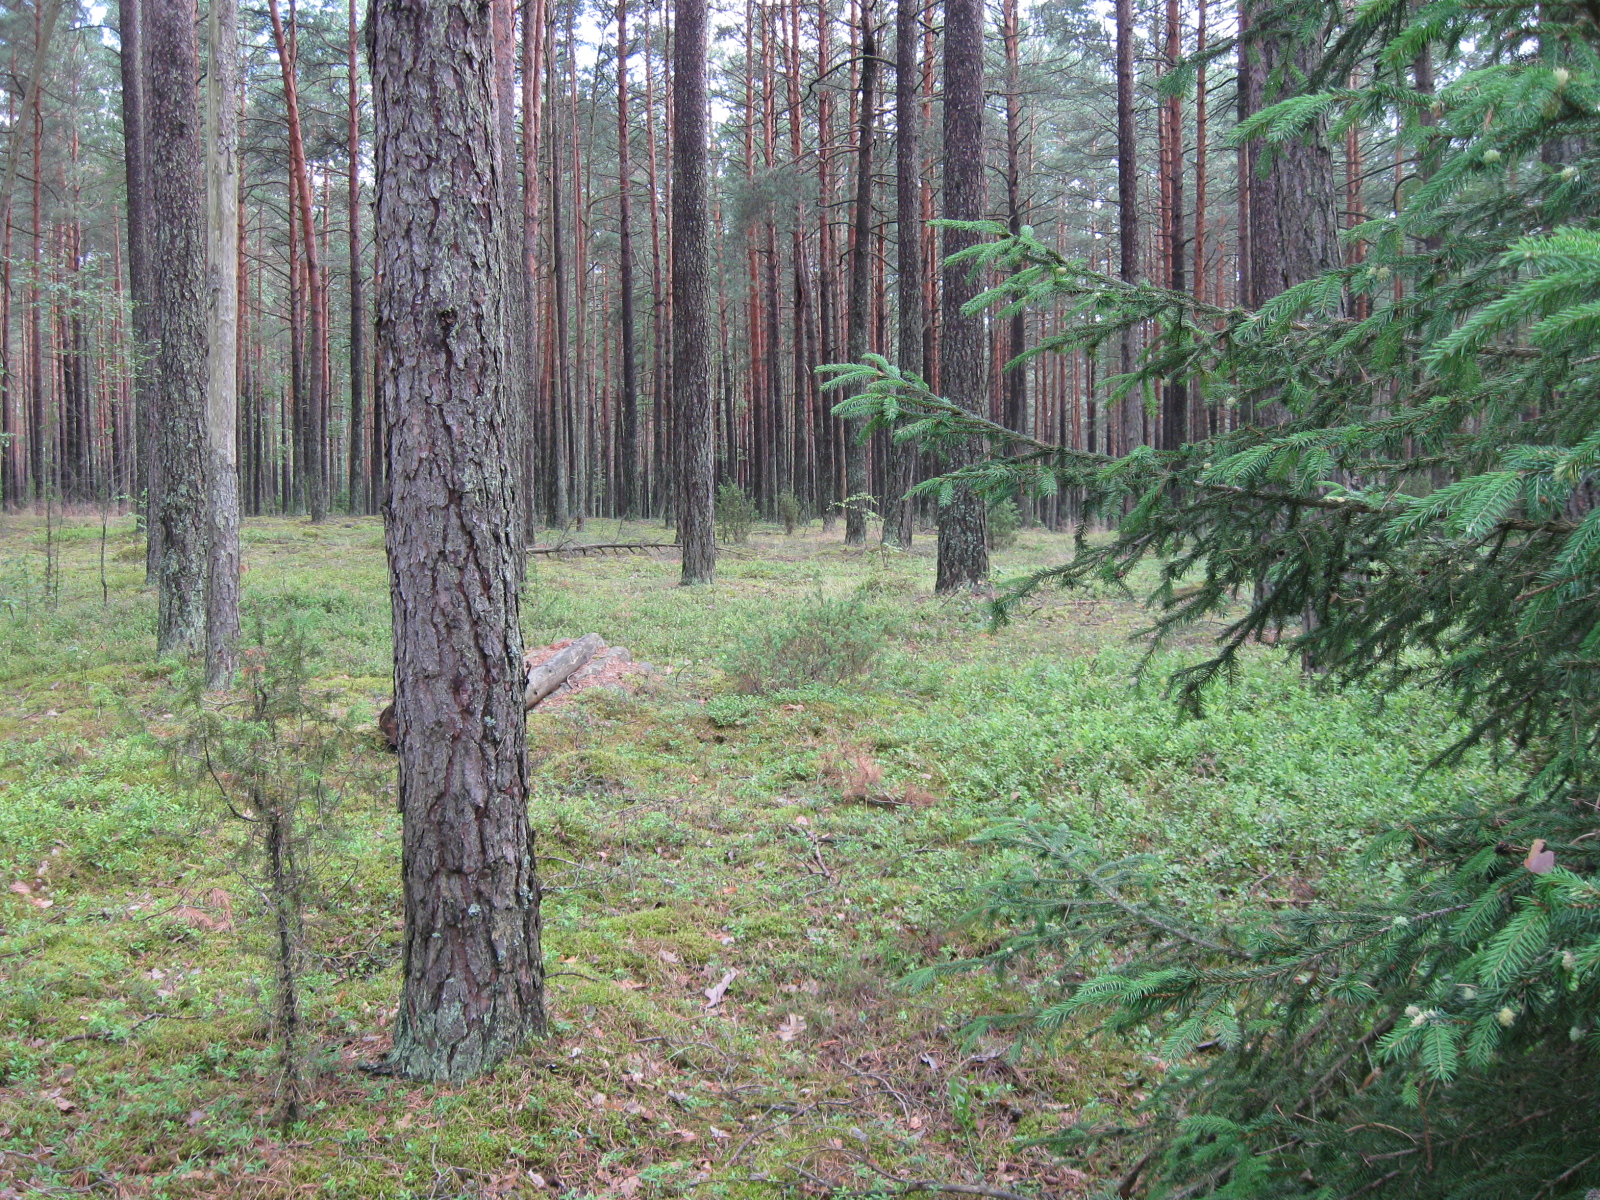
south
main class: Woodland
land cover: Pine dominated coniferous woodland
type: hemiboreal forest and nemoral coniferous forest and mixed broadleaved-coniferous forest
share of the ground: 50 - 75 %
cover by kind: coniferous forest trees 65 %, shrubs 15 %, lichens and mosses 10 %, broadleaved forest trees 5 %, herbaceous plants 5 %
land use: Forestry
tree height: > 5 m
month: July
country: LT
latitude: 53.9716
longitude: 23.5143
